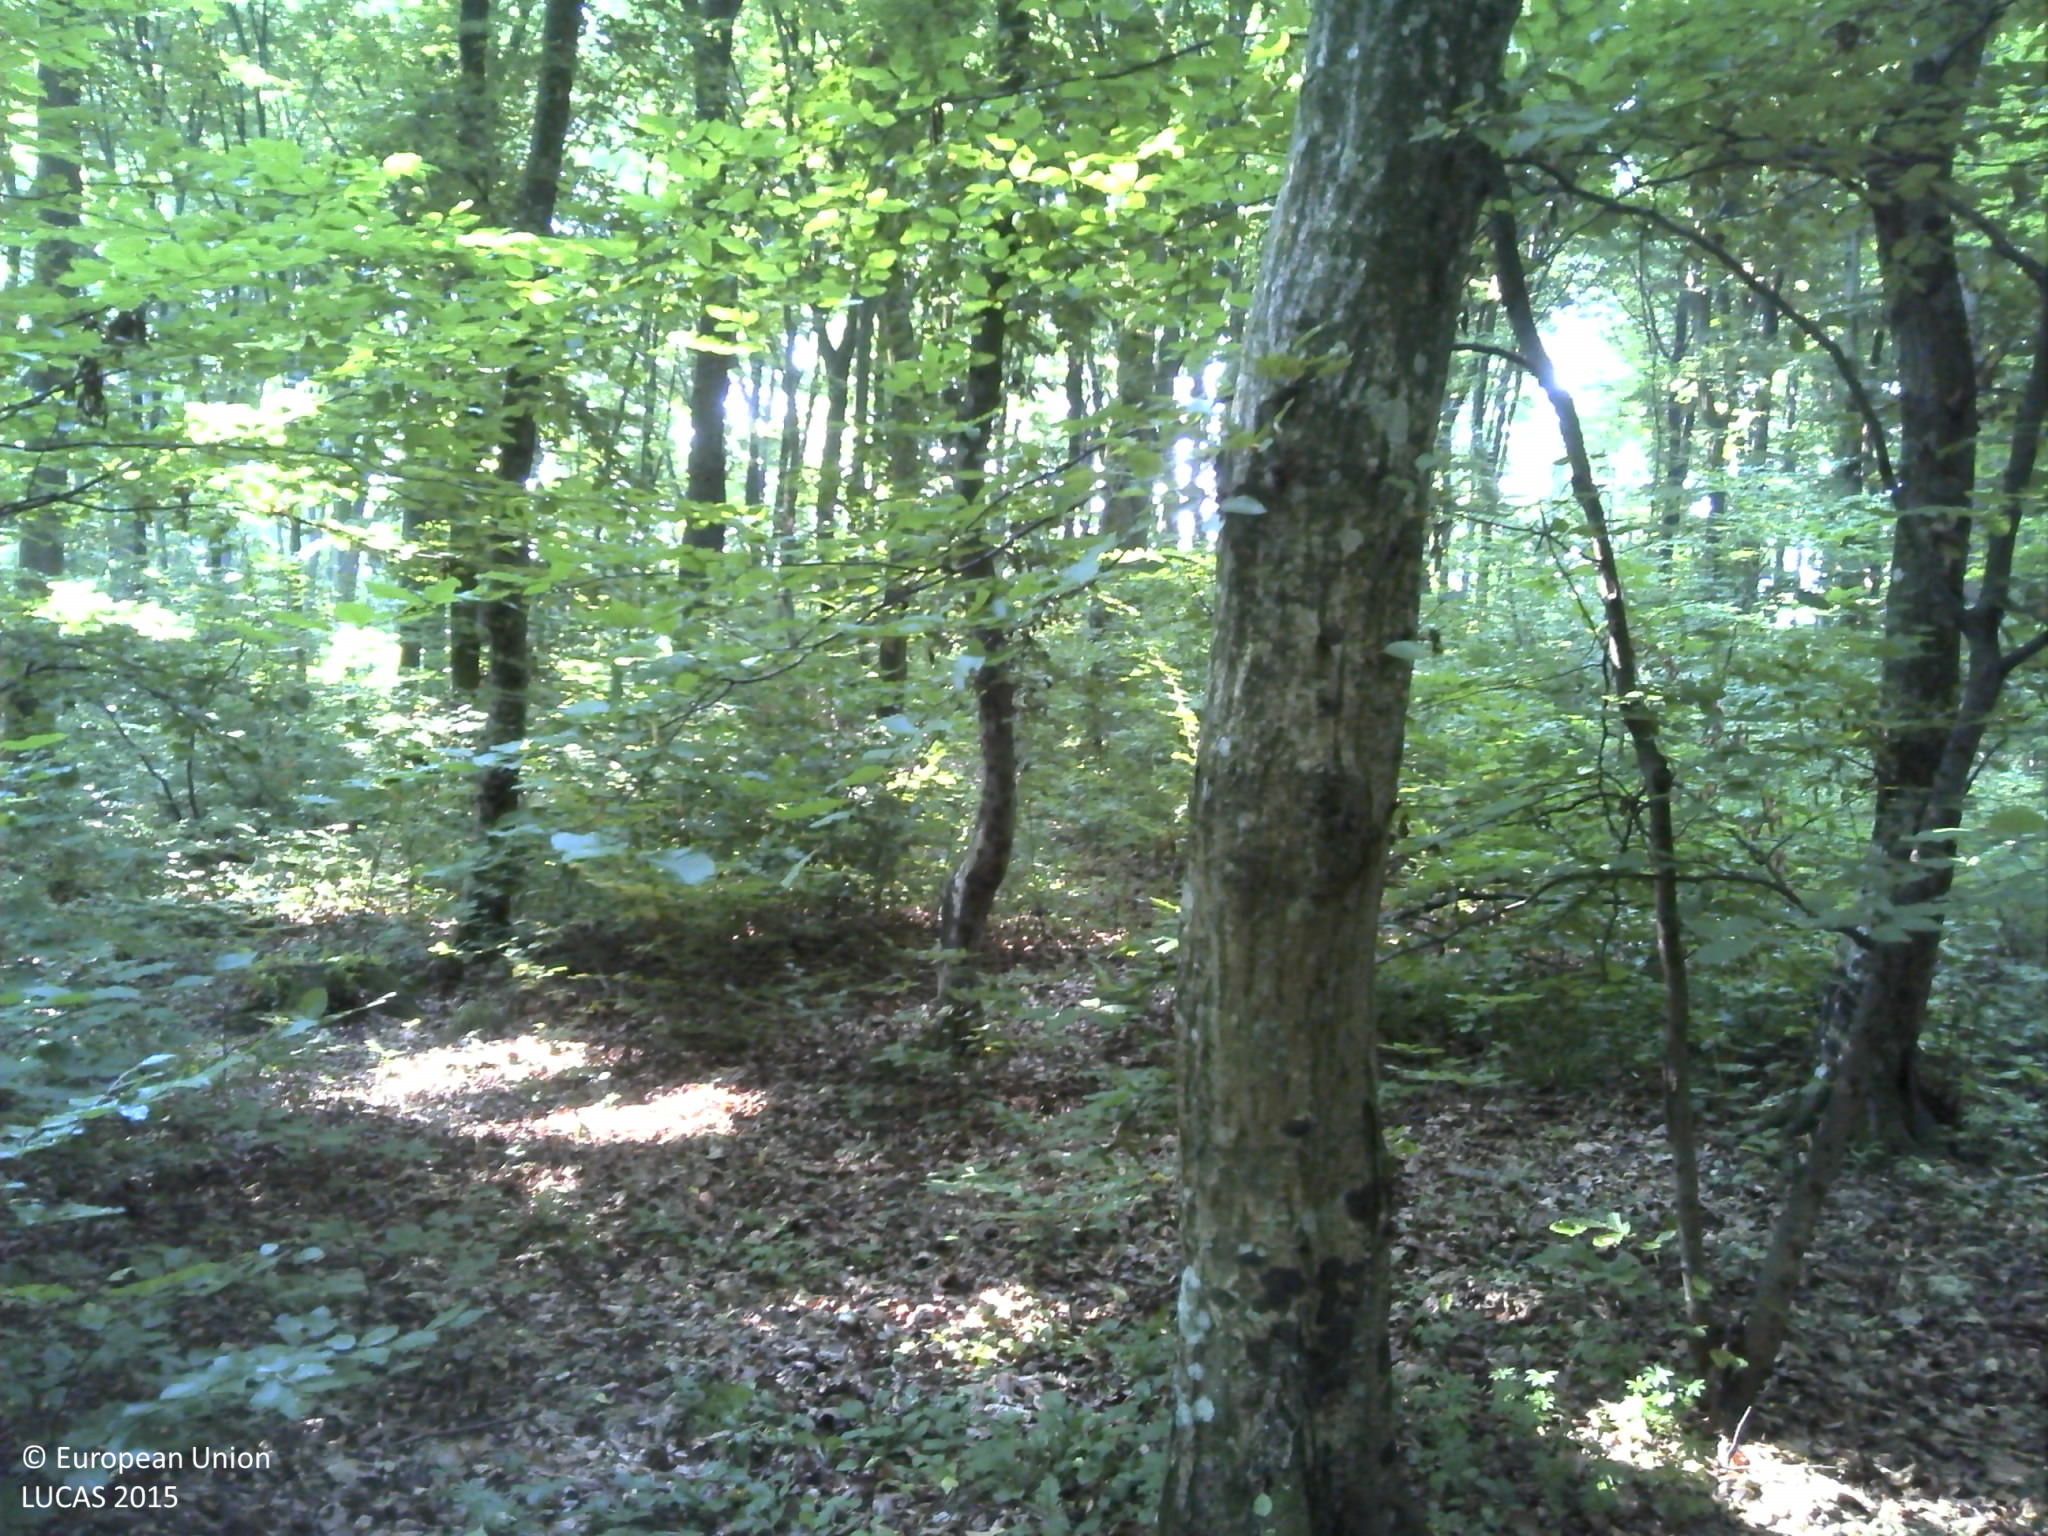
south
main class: Woodland
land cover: Broadleaved woodland
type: acidophilous oak and oak-birch forest
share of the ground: > 75 %
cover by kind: broadleaved forest trees 90 %, shrubs 5 %, herbaceous plants 5 %
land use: Forestry
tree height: > 5 m
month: July
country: HR
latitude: 45.9752
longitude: 16.7506
